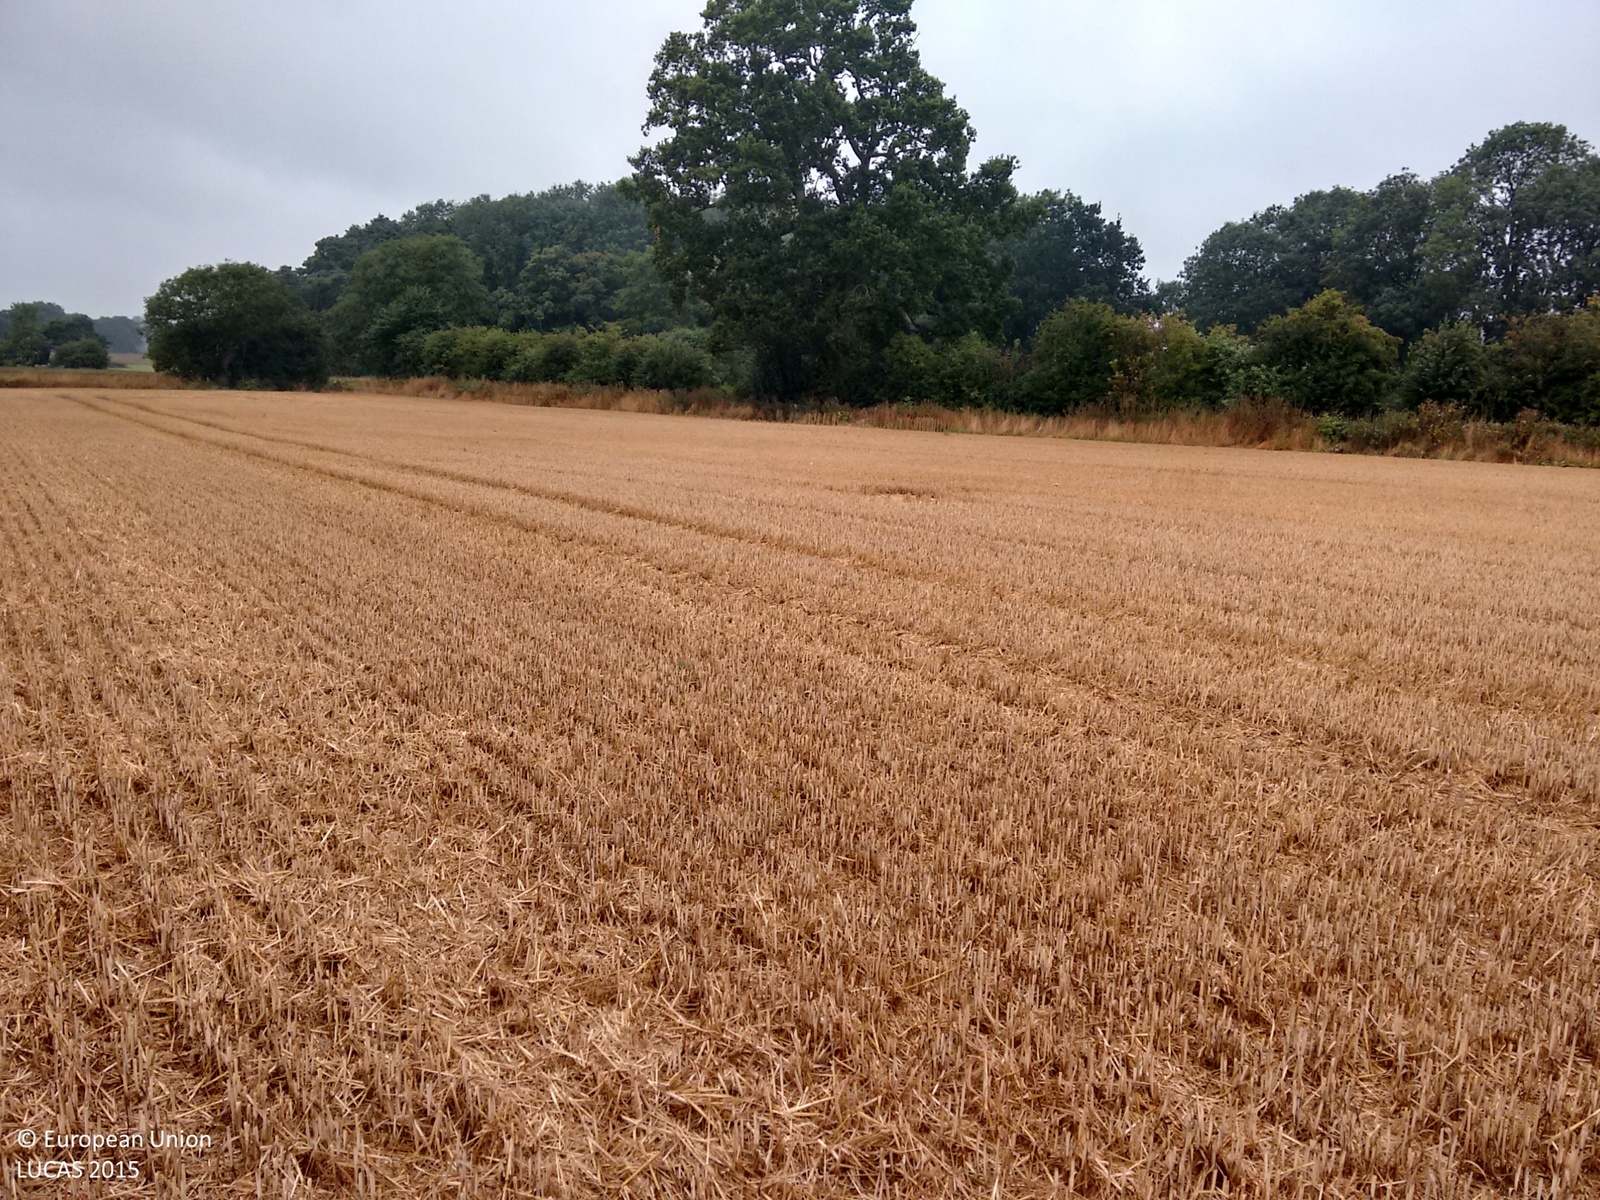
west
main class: Cropland
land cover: Common wheat
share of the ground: > 75 %
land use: Agriculture (excluding fallow land and kitchen gardens)
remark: Harvested field
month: August
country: GB
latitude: 52.7773
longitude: 0.7692
